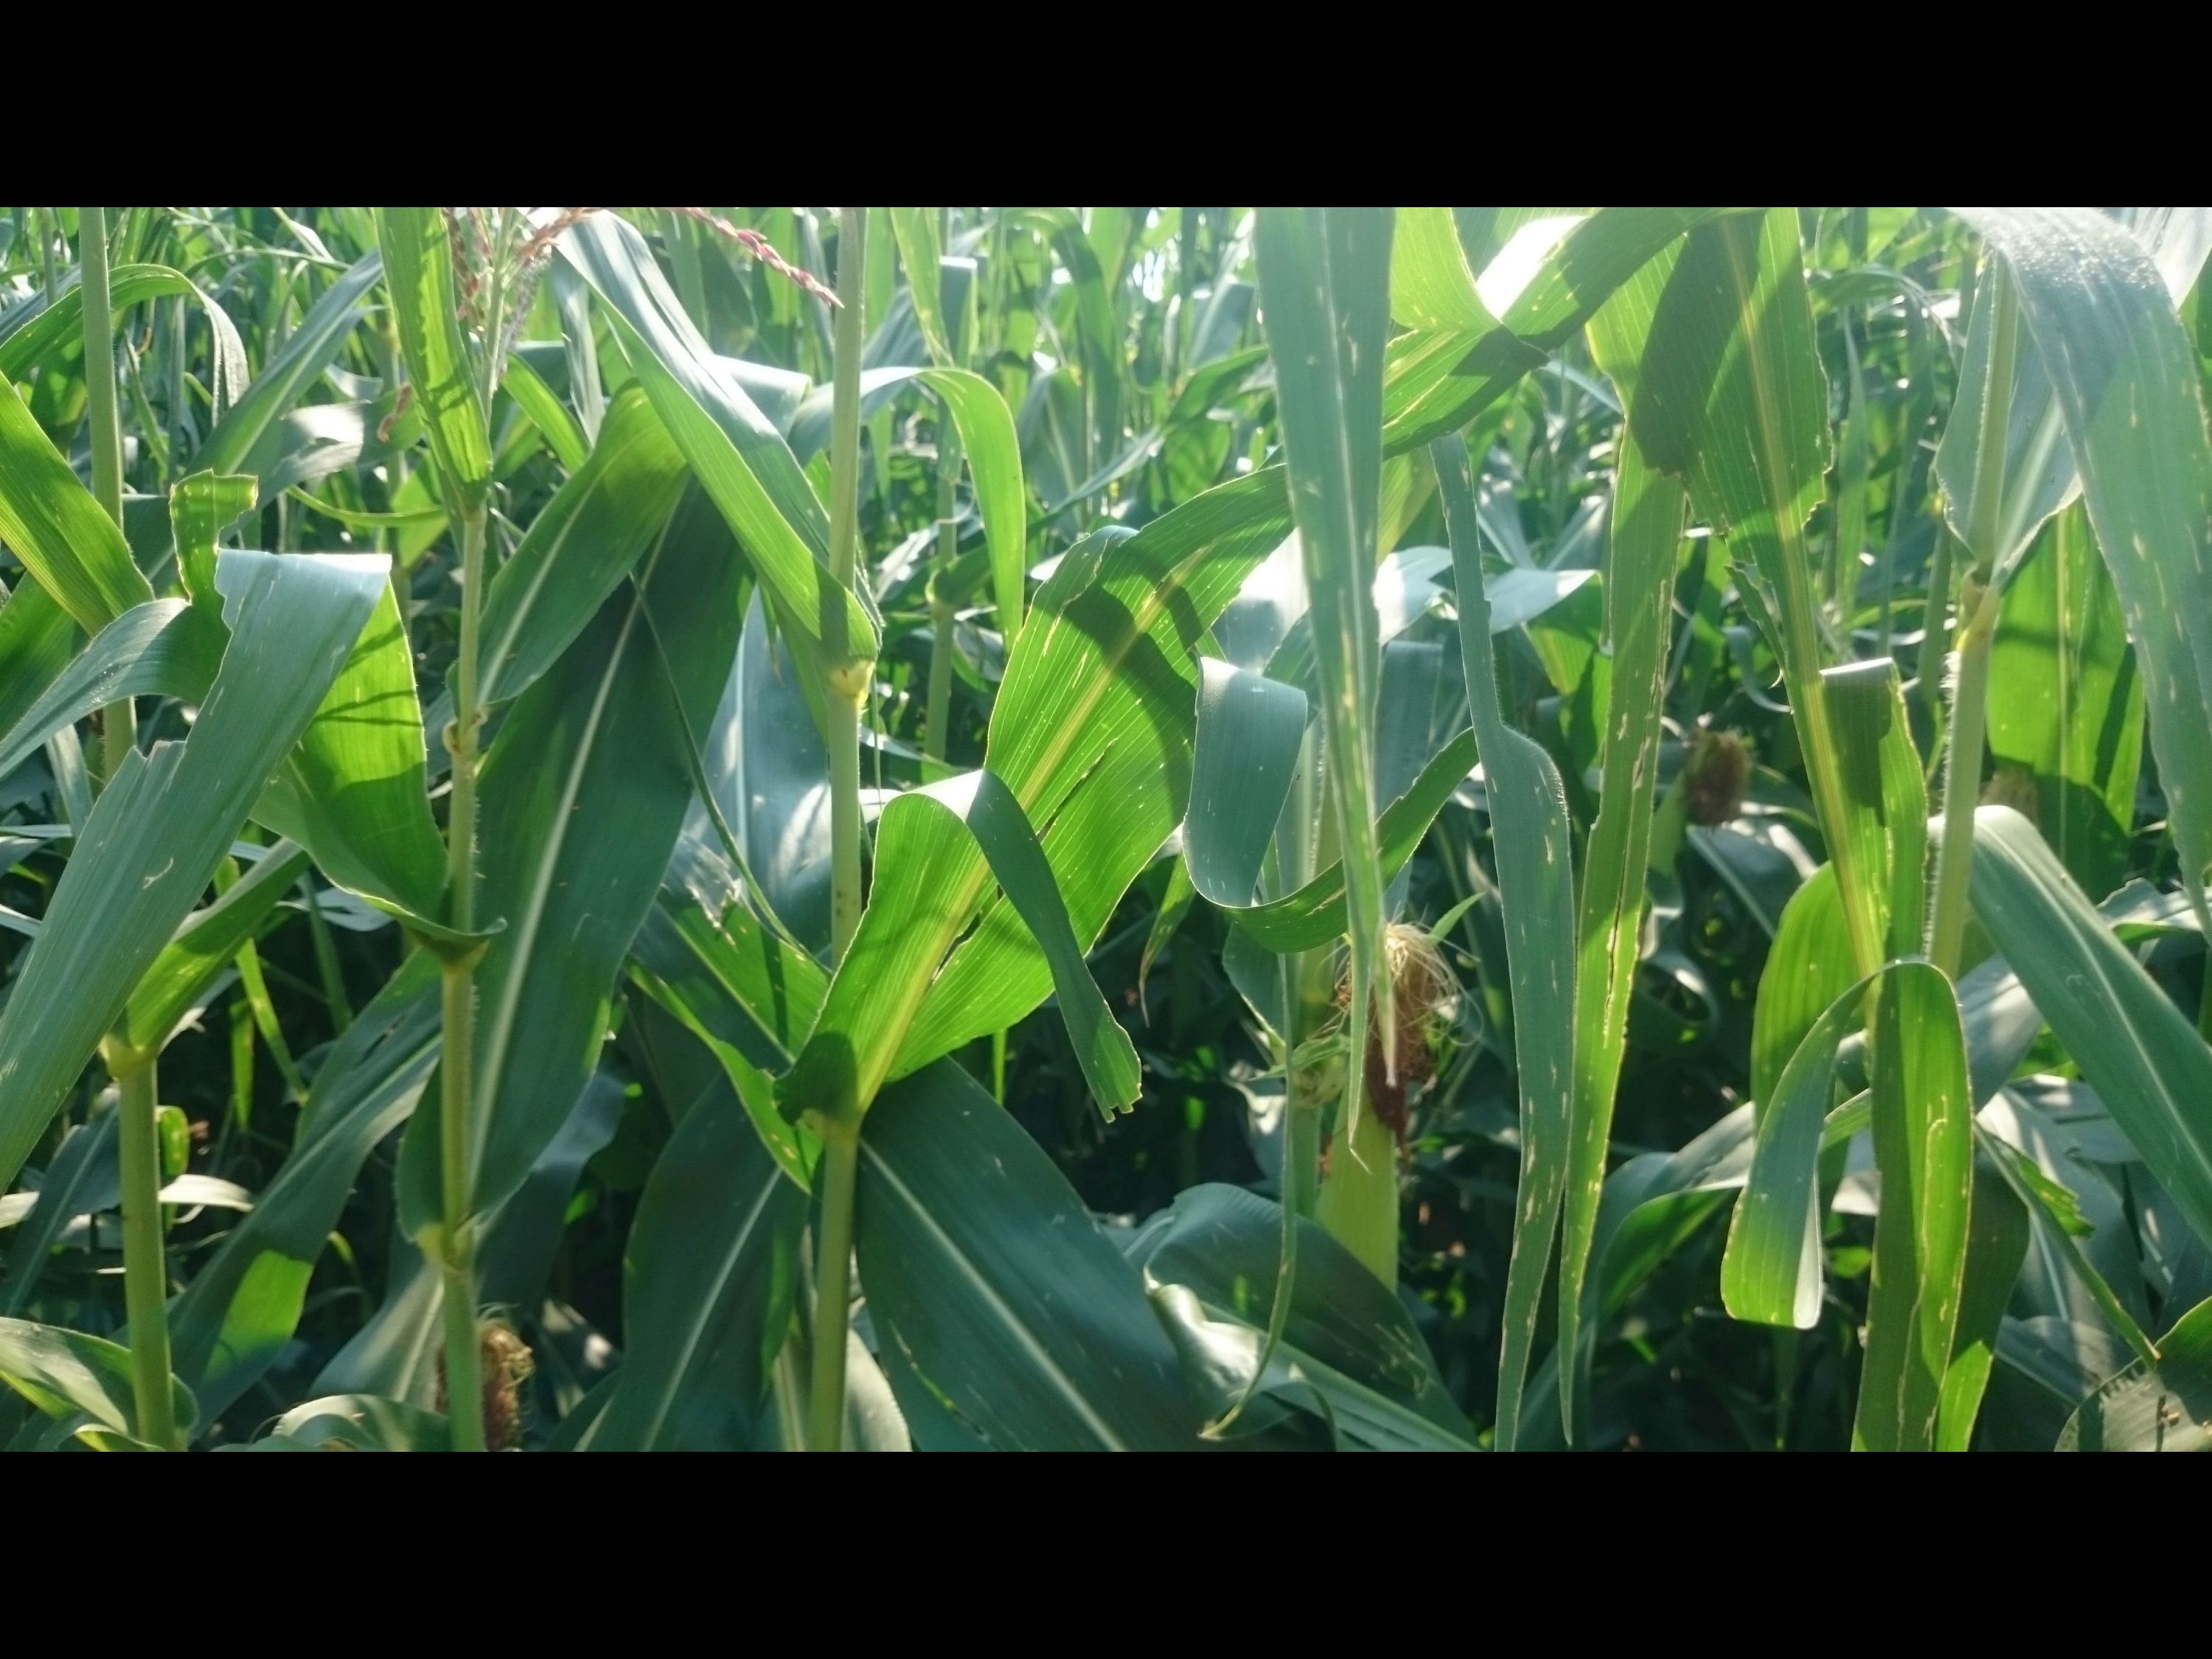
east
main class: Cropland
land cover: Maize
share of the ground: > 75 %
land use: Agriculture (excluding fallow land and kitchen gardens)
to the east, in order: Maize; Fences; Grassland with sparse tree/shrub cover; Artificial constructions in urban areas; Grass margins; Fences; Apple fruit; Fences; Spruce dominated mixed woodland; Tracks; Spruce dominated coniferous woodland
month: July
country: AT
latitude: 47.0531
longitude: 15.5949
